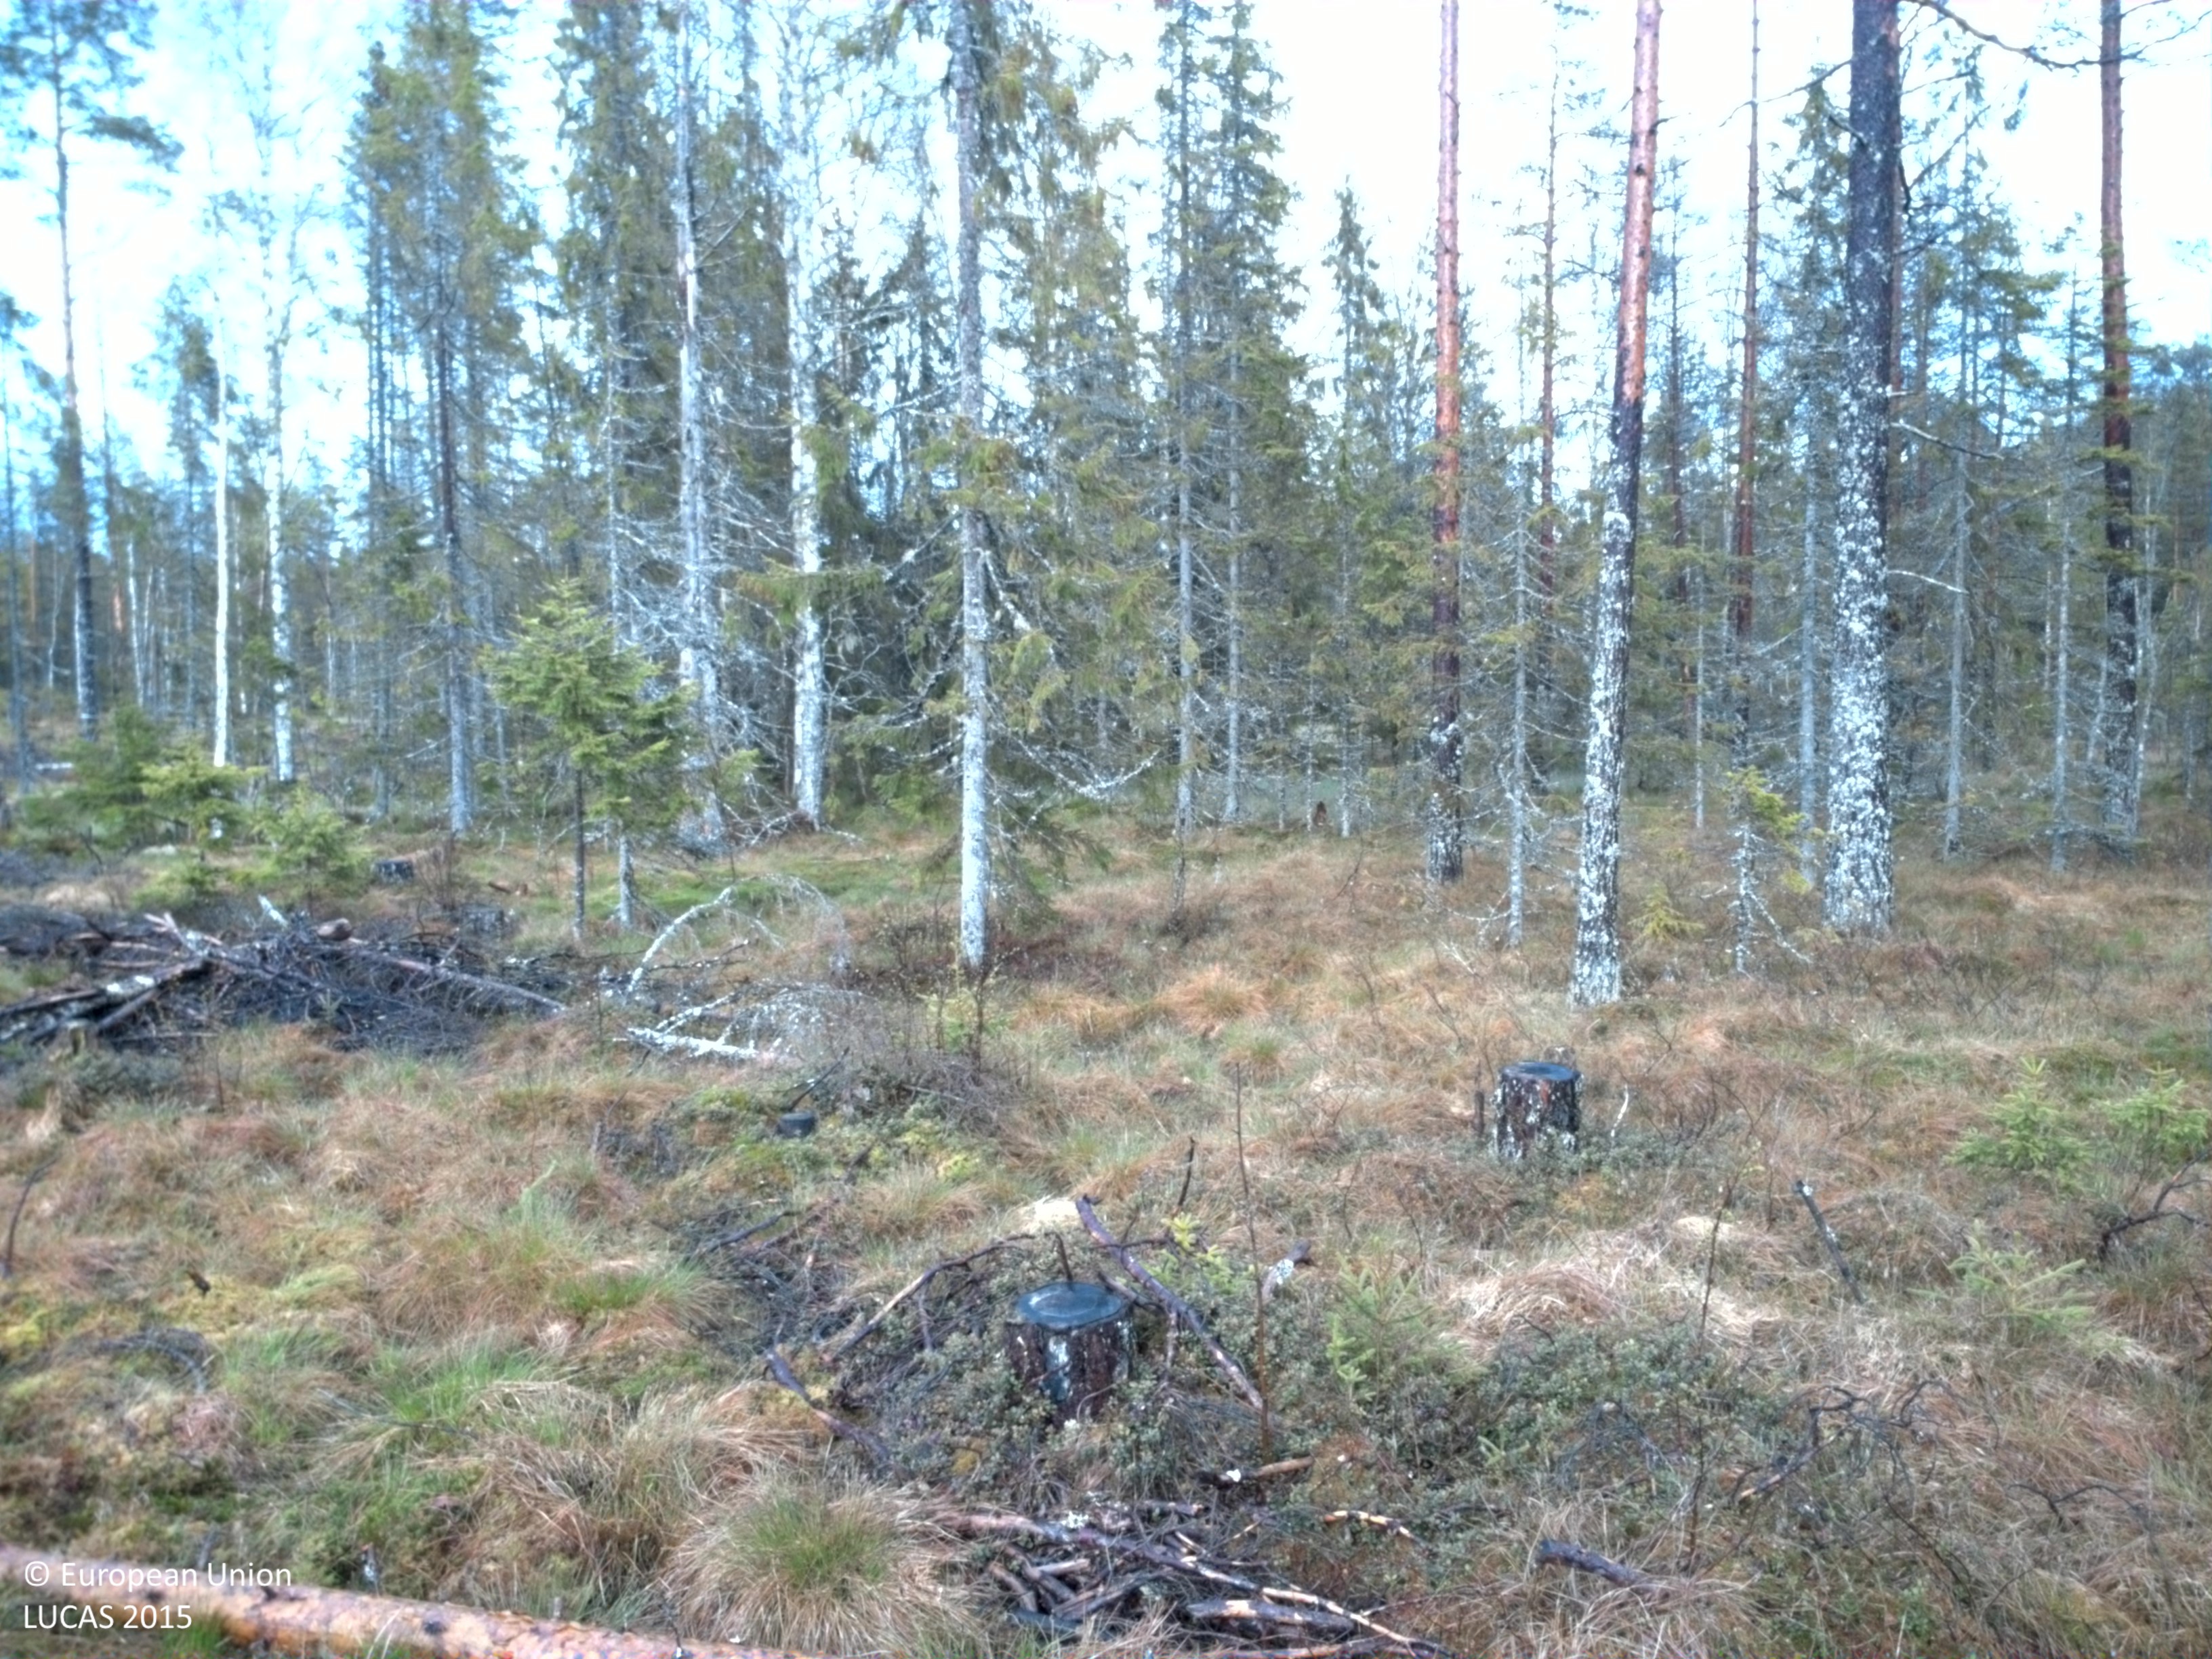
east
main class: Woodland
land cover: Spruce dominated mixed woodland
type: boreal forest
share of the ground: > 75 %
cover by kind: coniferous forest trees 55 %, broadleaved forest trees 25 %, herbaceous plants 10 %, shrubs 5 %, lichens and mosses 5 %
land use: Forestry
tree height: > 5 m
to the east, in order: Spruce dominated mixed woodland; Grassland with sparse tree/shrub cover; Spruce dominated mixed woodland; Rivers and streams; Spruce dominated mixed woodland; Rivers and streams; Pine dominated mixed woodland; Other mixed woodland; Peatbogs
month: May
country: SE
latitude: 61.1444
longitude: 14.8339
